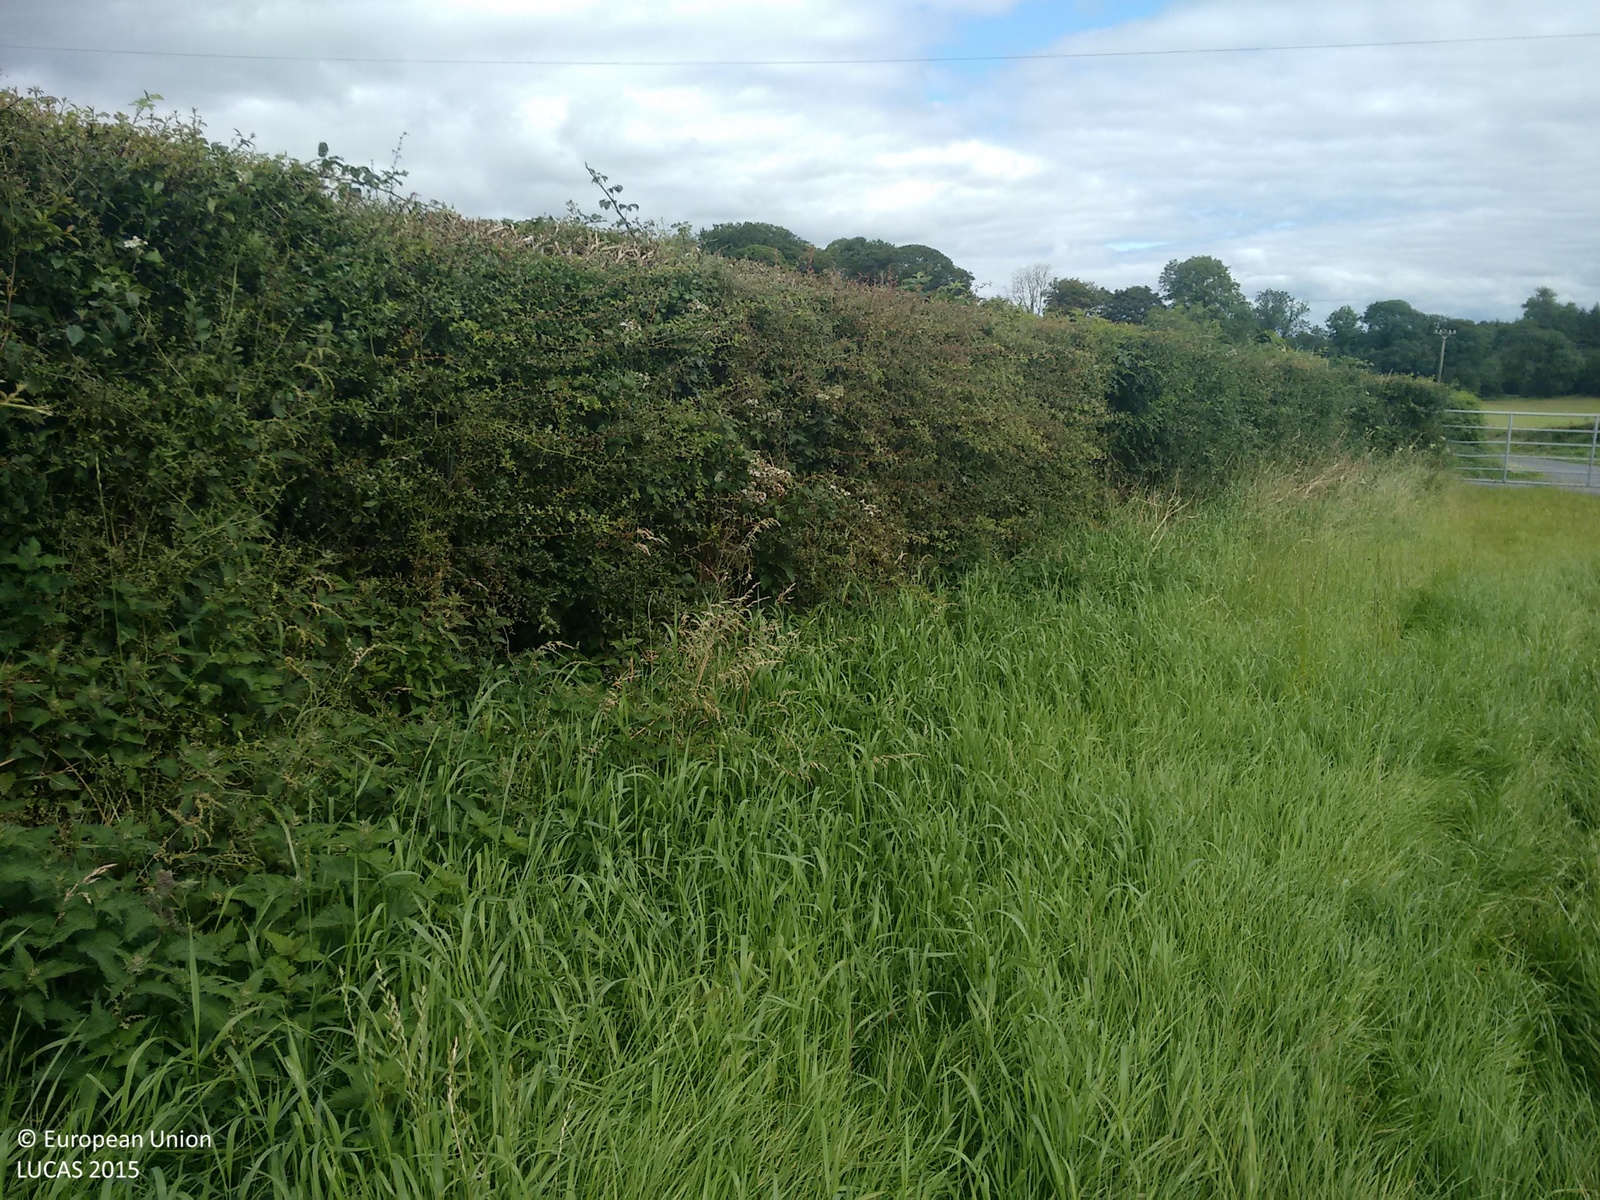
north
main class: Grassland
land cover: Grassland without tree/shrub cover
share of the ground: > 75 %
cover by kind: herbaceous plants 100 %
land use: Agriculture (excluding fallow land and kitchen gardens)
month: August
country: GB
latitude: 54.3114
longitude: -6.8114
